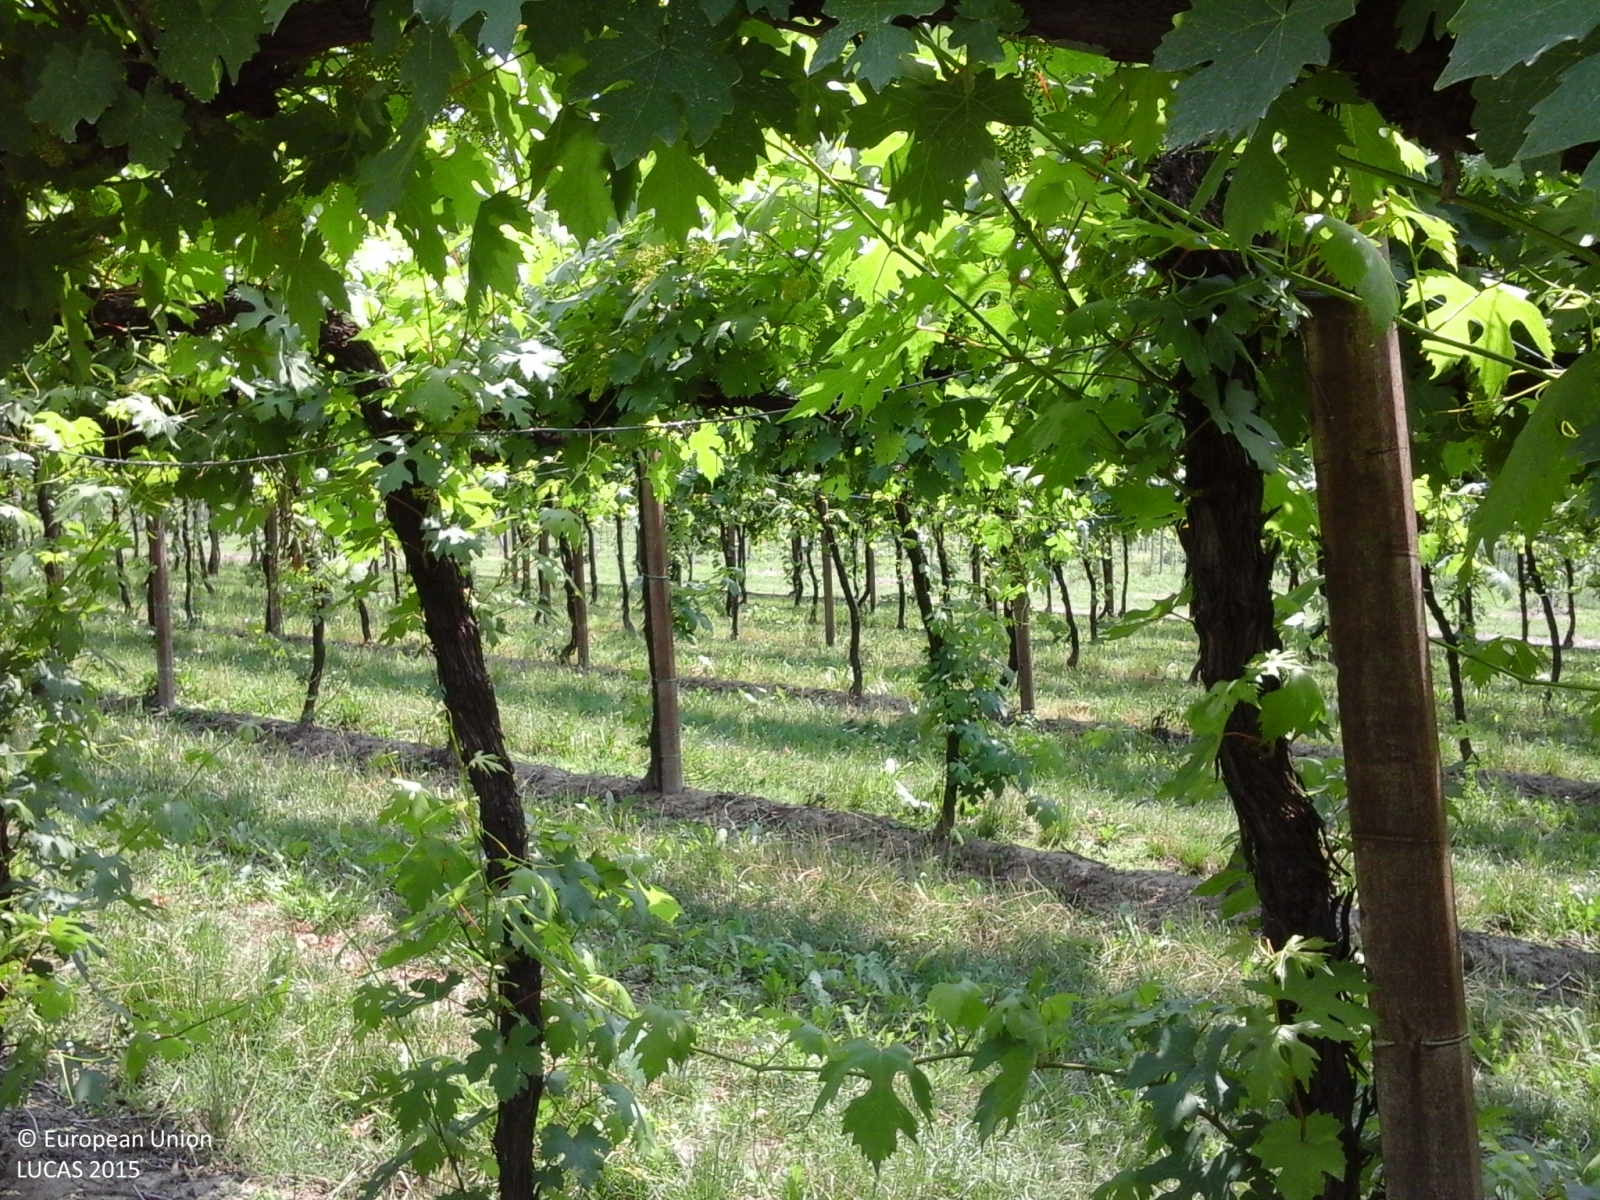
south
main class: Cropland
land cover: Vineyards
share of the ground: 50 - 75 %
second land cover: Grassland without tree/shrub cover
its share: > 75 %
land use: Agriculture (excluding fallow land and kitchen gardens)
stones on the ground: < 10 %
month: May
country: IT
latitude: 44.7987
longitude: 10.7443
